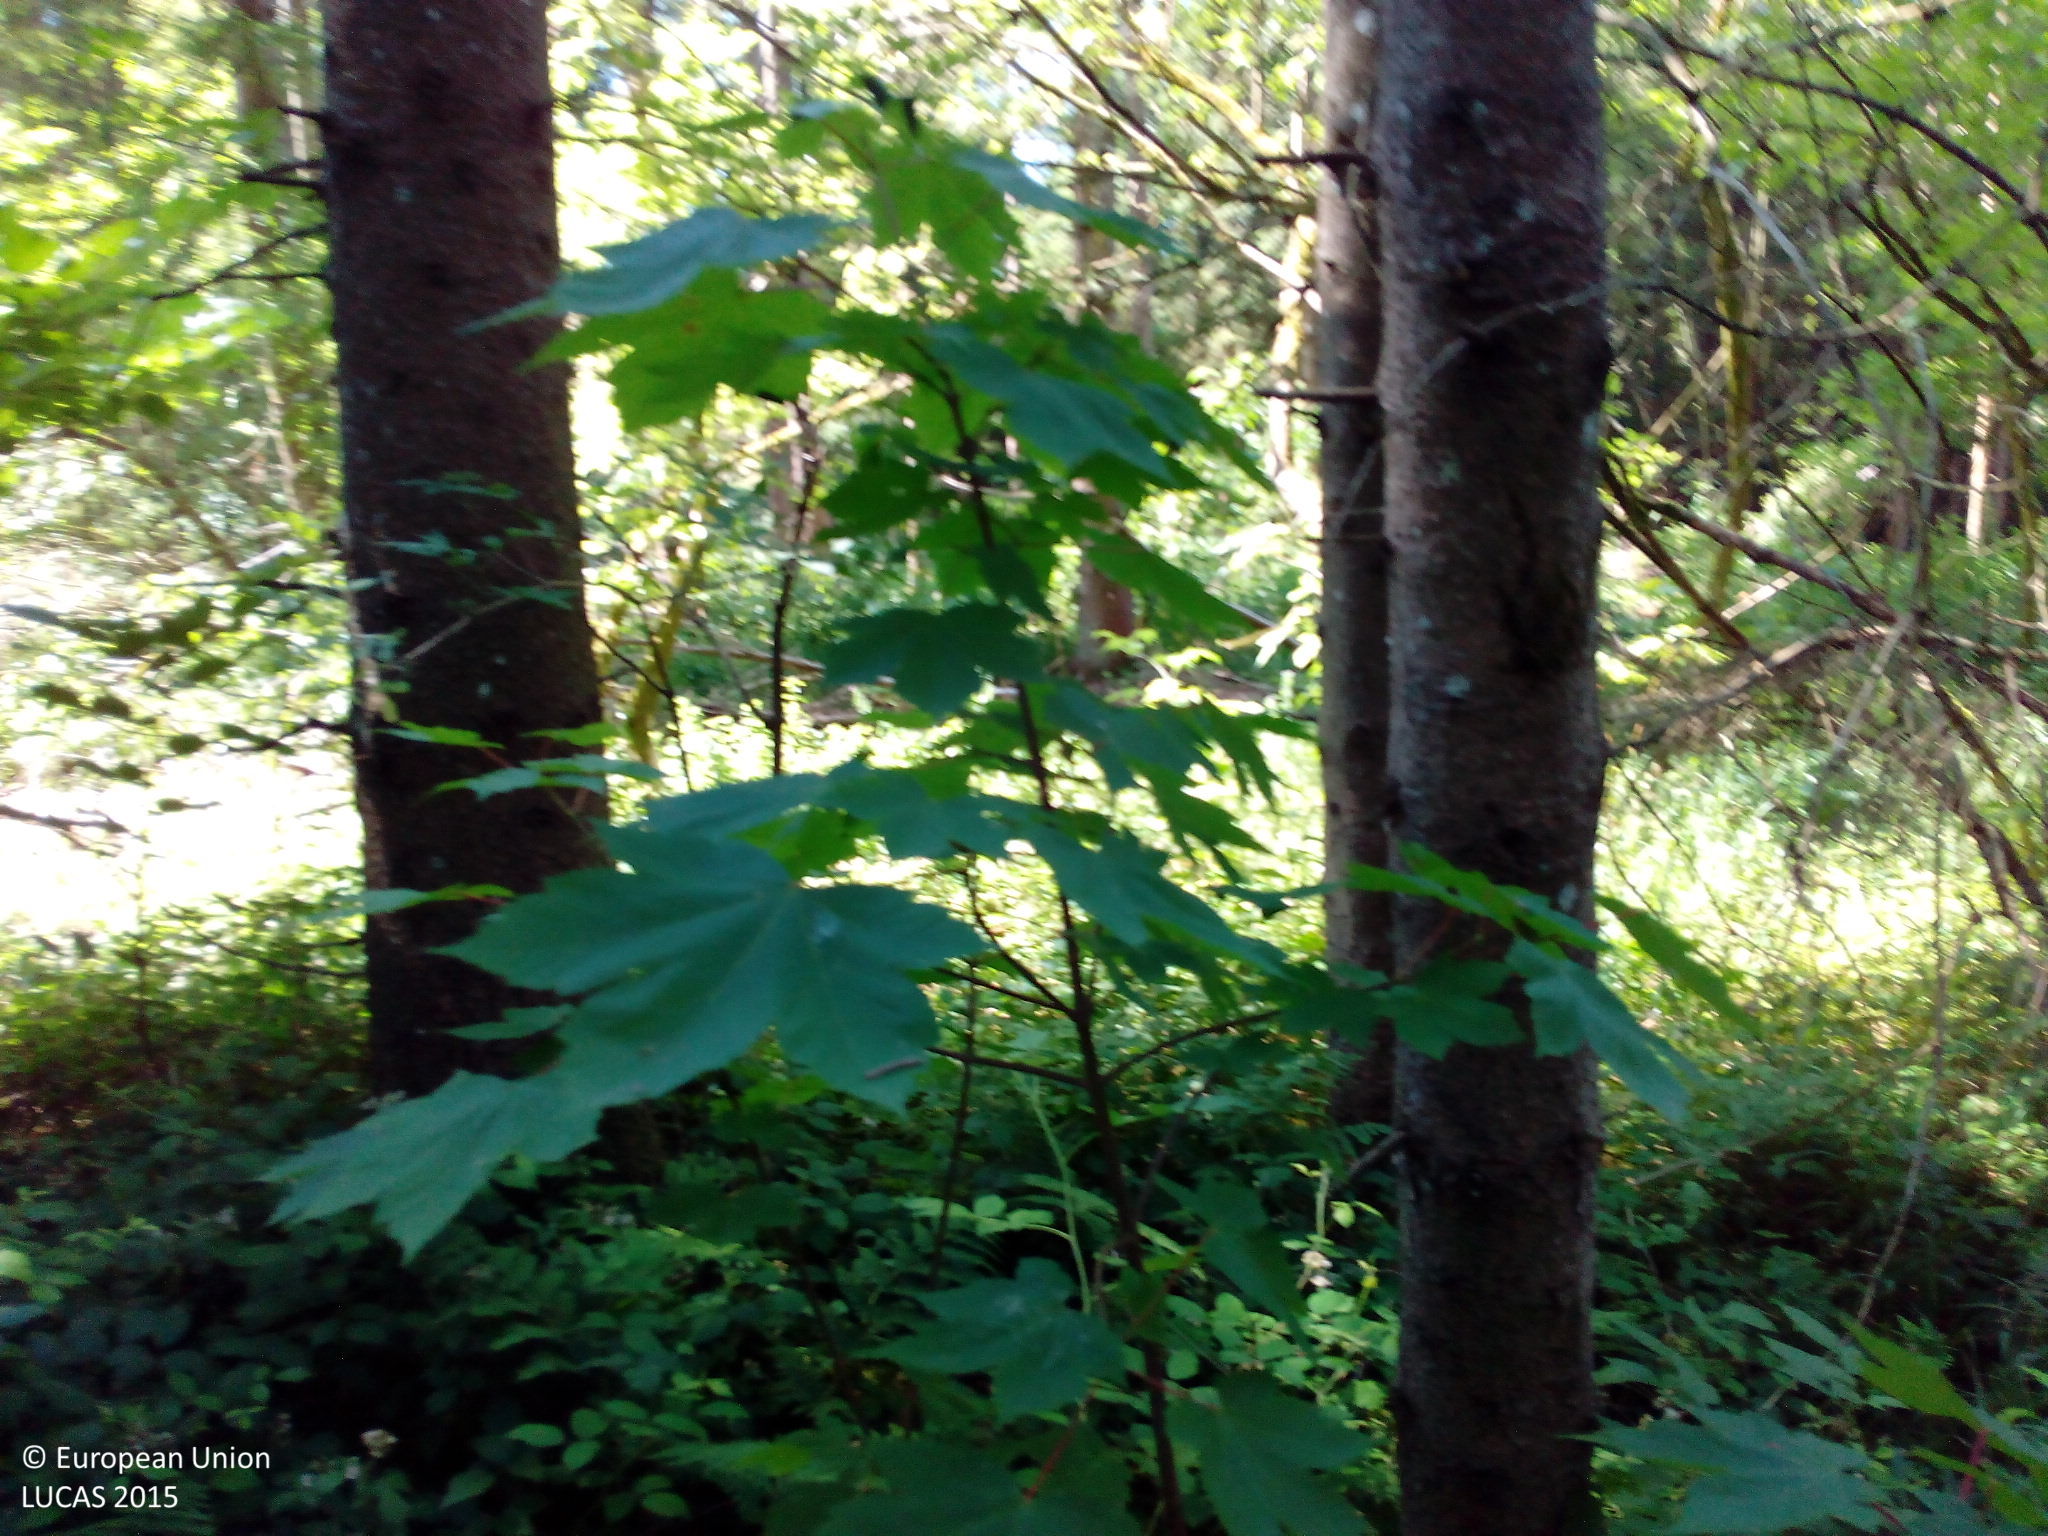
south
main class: Woodland
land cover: Spruce dominated coniferous woodland
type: hemiboreal forest and nemoral coniferous forest and mixed broadleaved-coniferous forest
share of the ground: > 75 %
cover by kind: coniferous forest trees 80 %, broadleaved forest trees 10 %, shrubs 5 %, herbaceous plants 5 %
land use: Forestry
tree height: > 5 m
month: July
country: DE
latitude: 47.7653
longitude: 11.3466
